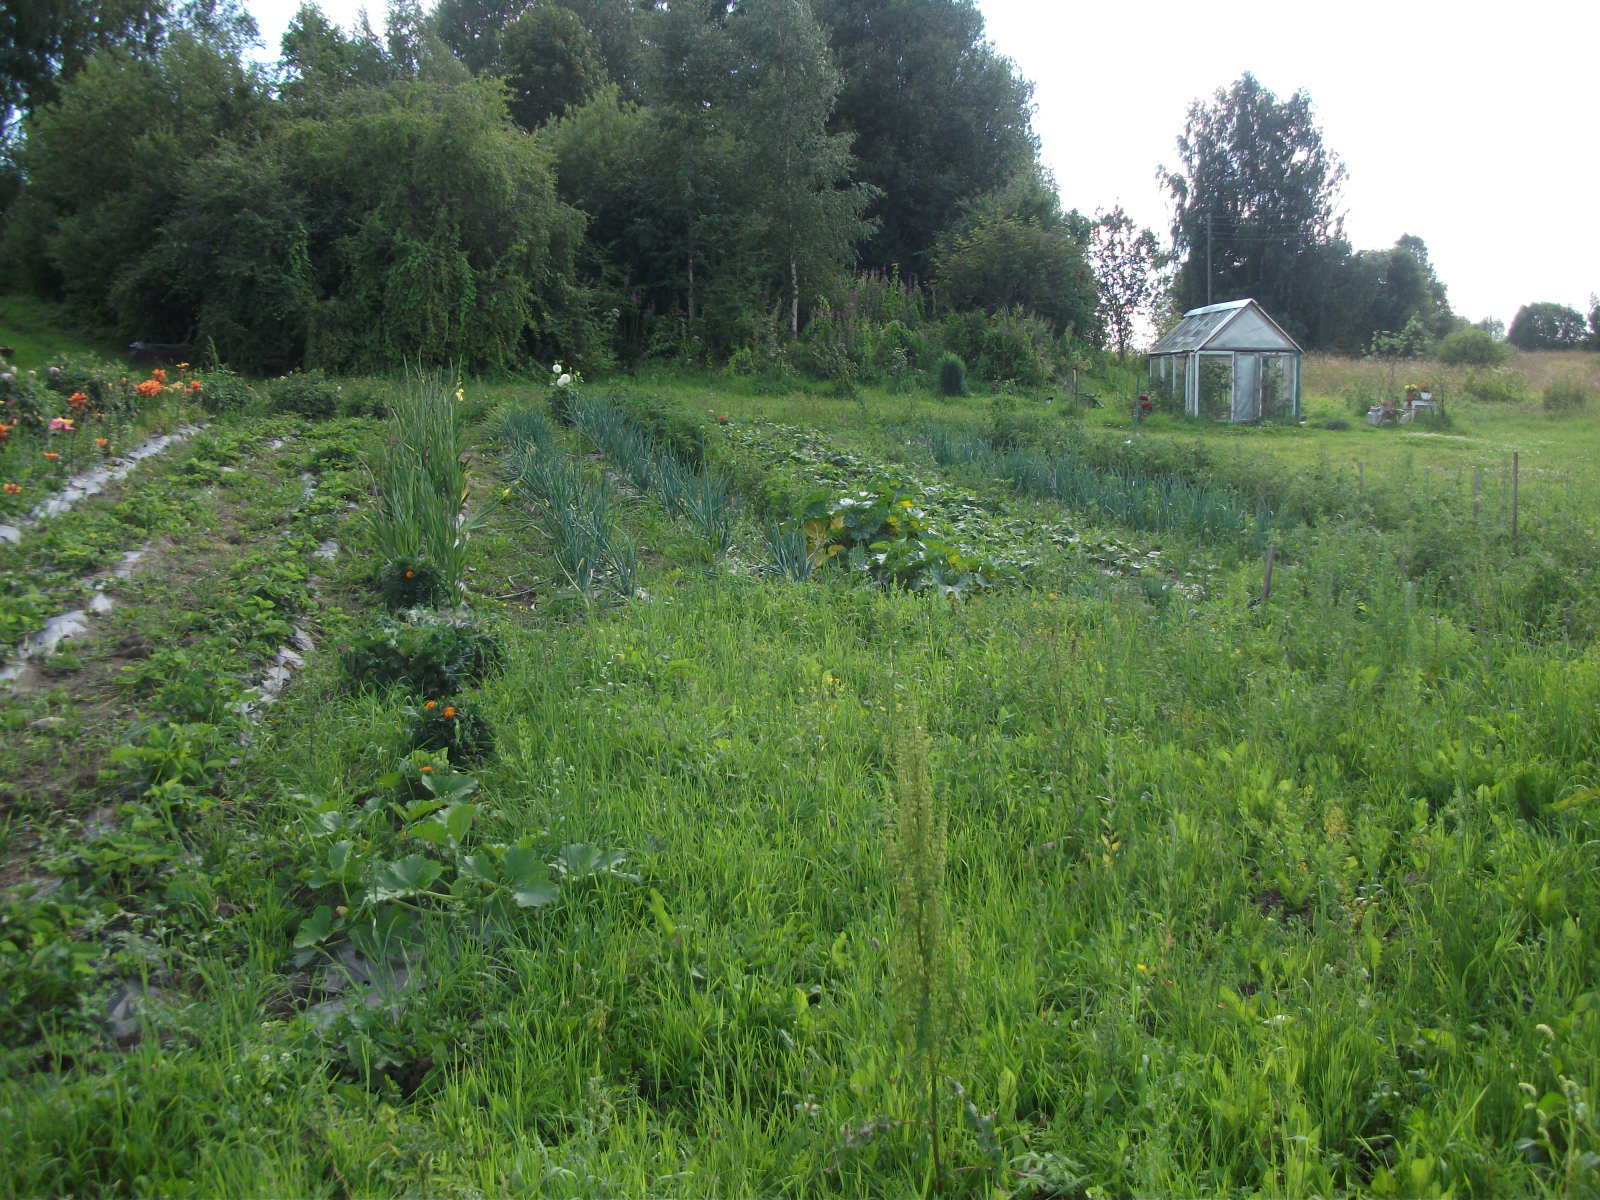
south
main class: Grassland
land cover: Grassland without tree/shrub cover
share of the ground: > 75 %
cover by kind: herbaceous plants 100 %
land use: Agriculture (excluding fallow land and kitchen gardens)
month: August
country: LV
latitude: 57.0797
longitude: 26.6303
